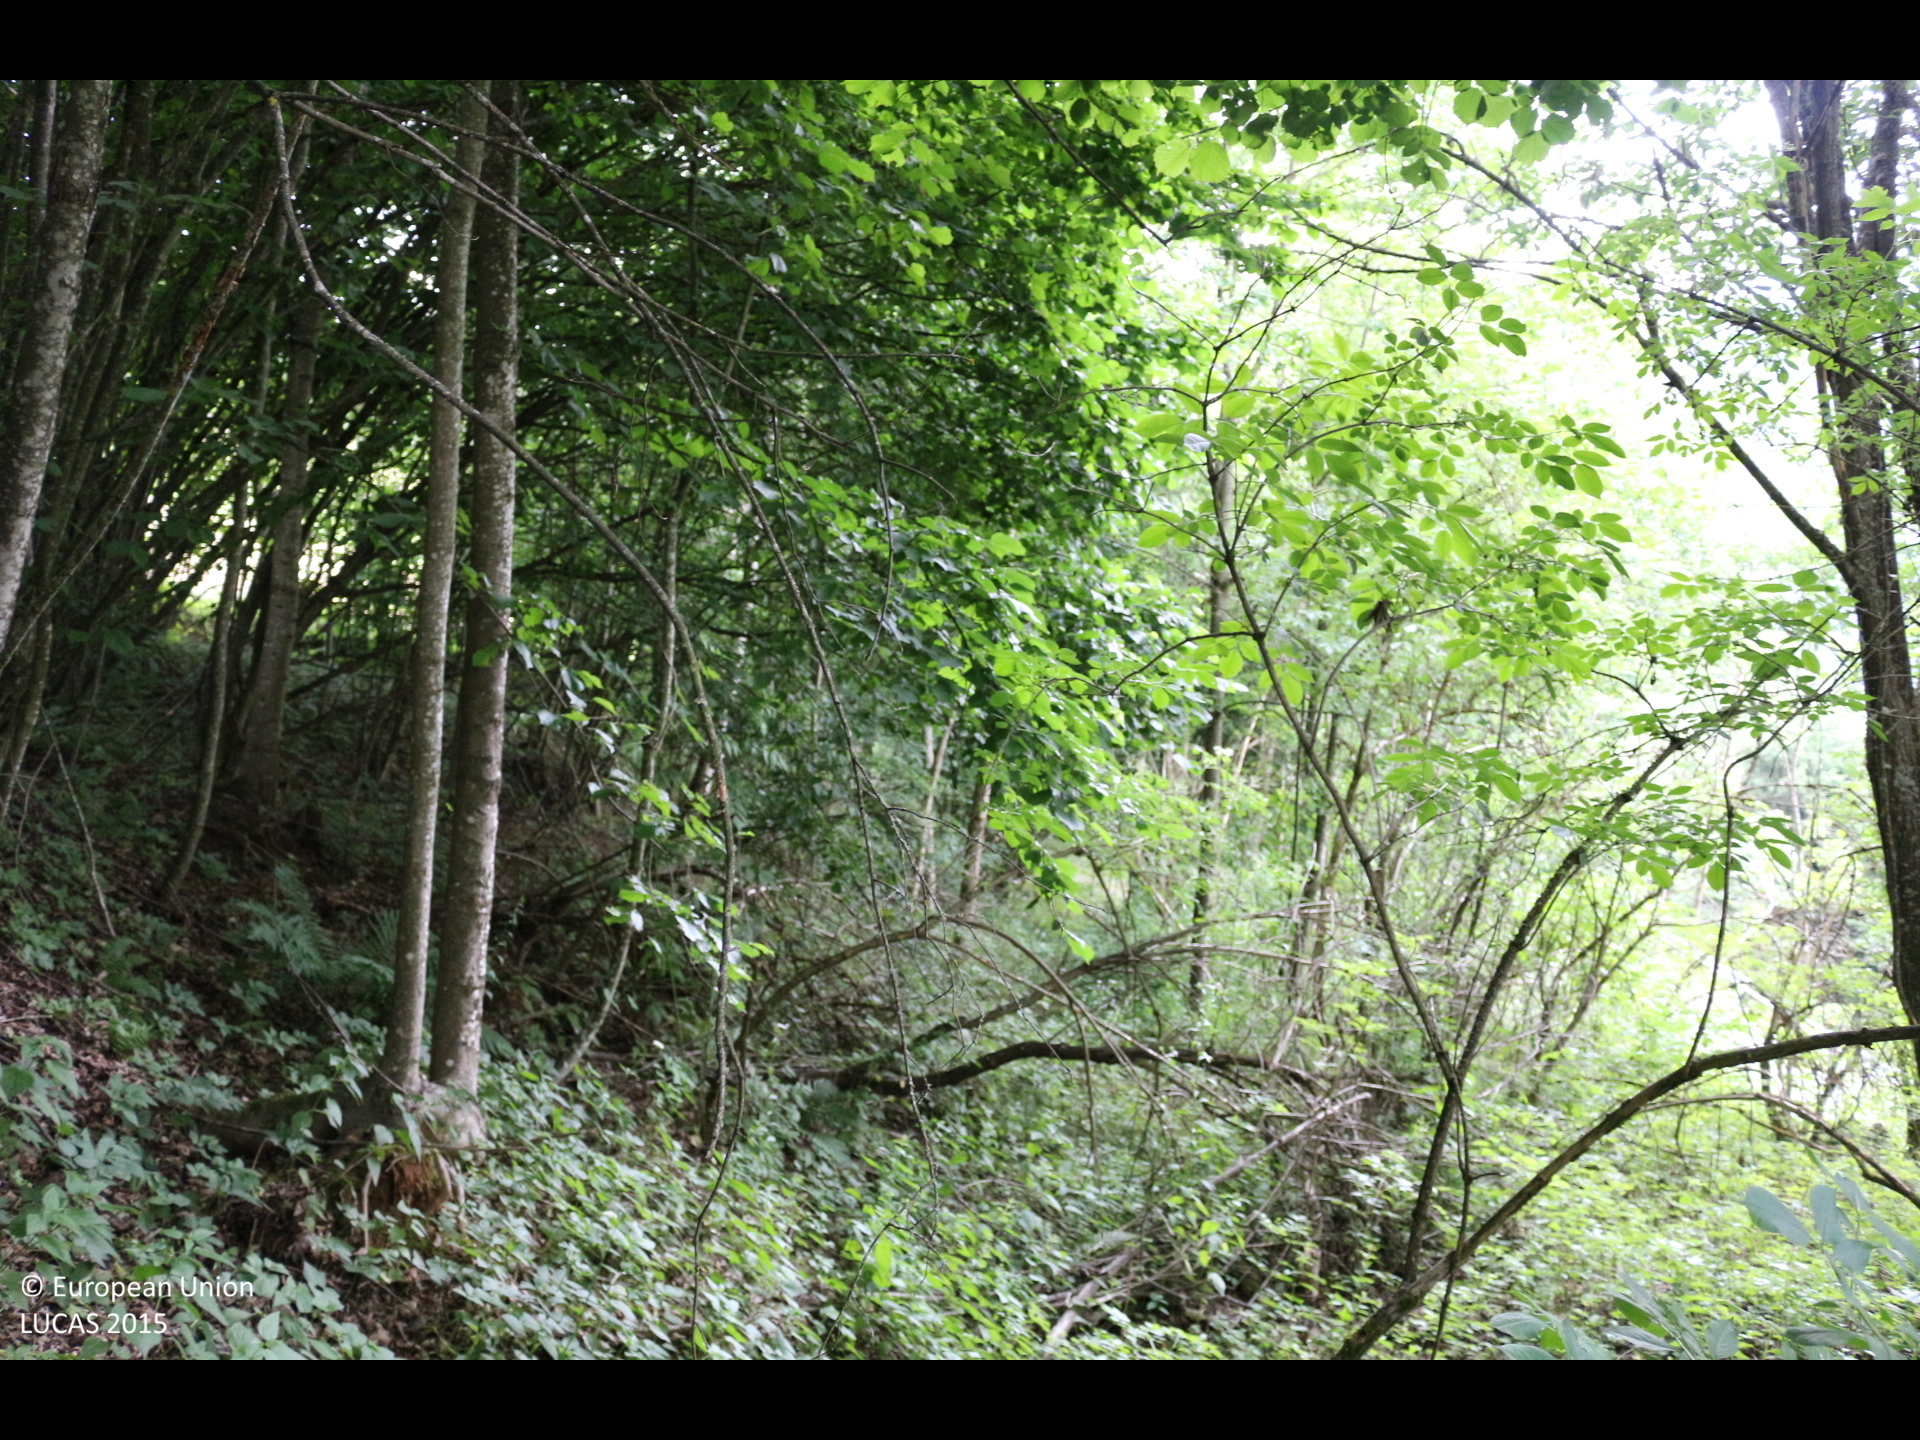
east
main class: Woodland
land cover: Broadleaved woodland
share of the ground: > 75 %
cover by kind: broadleaved forest trees 90 %, herbaceous plants 10 %
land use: Forestry
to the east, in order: Broadleaved woodland; Tracks; Broadleaved woodland; Fences; Broadleaved woodland; Spruce dominated mixed woodland; Grassland without tree/shrub cover; Spruce dominated mixed woodland
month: June
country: AT
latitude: 46.8784
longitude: 14.2886
